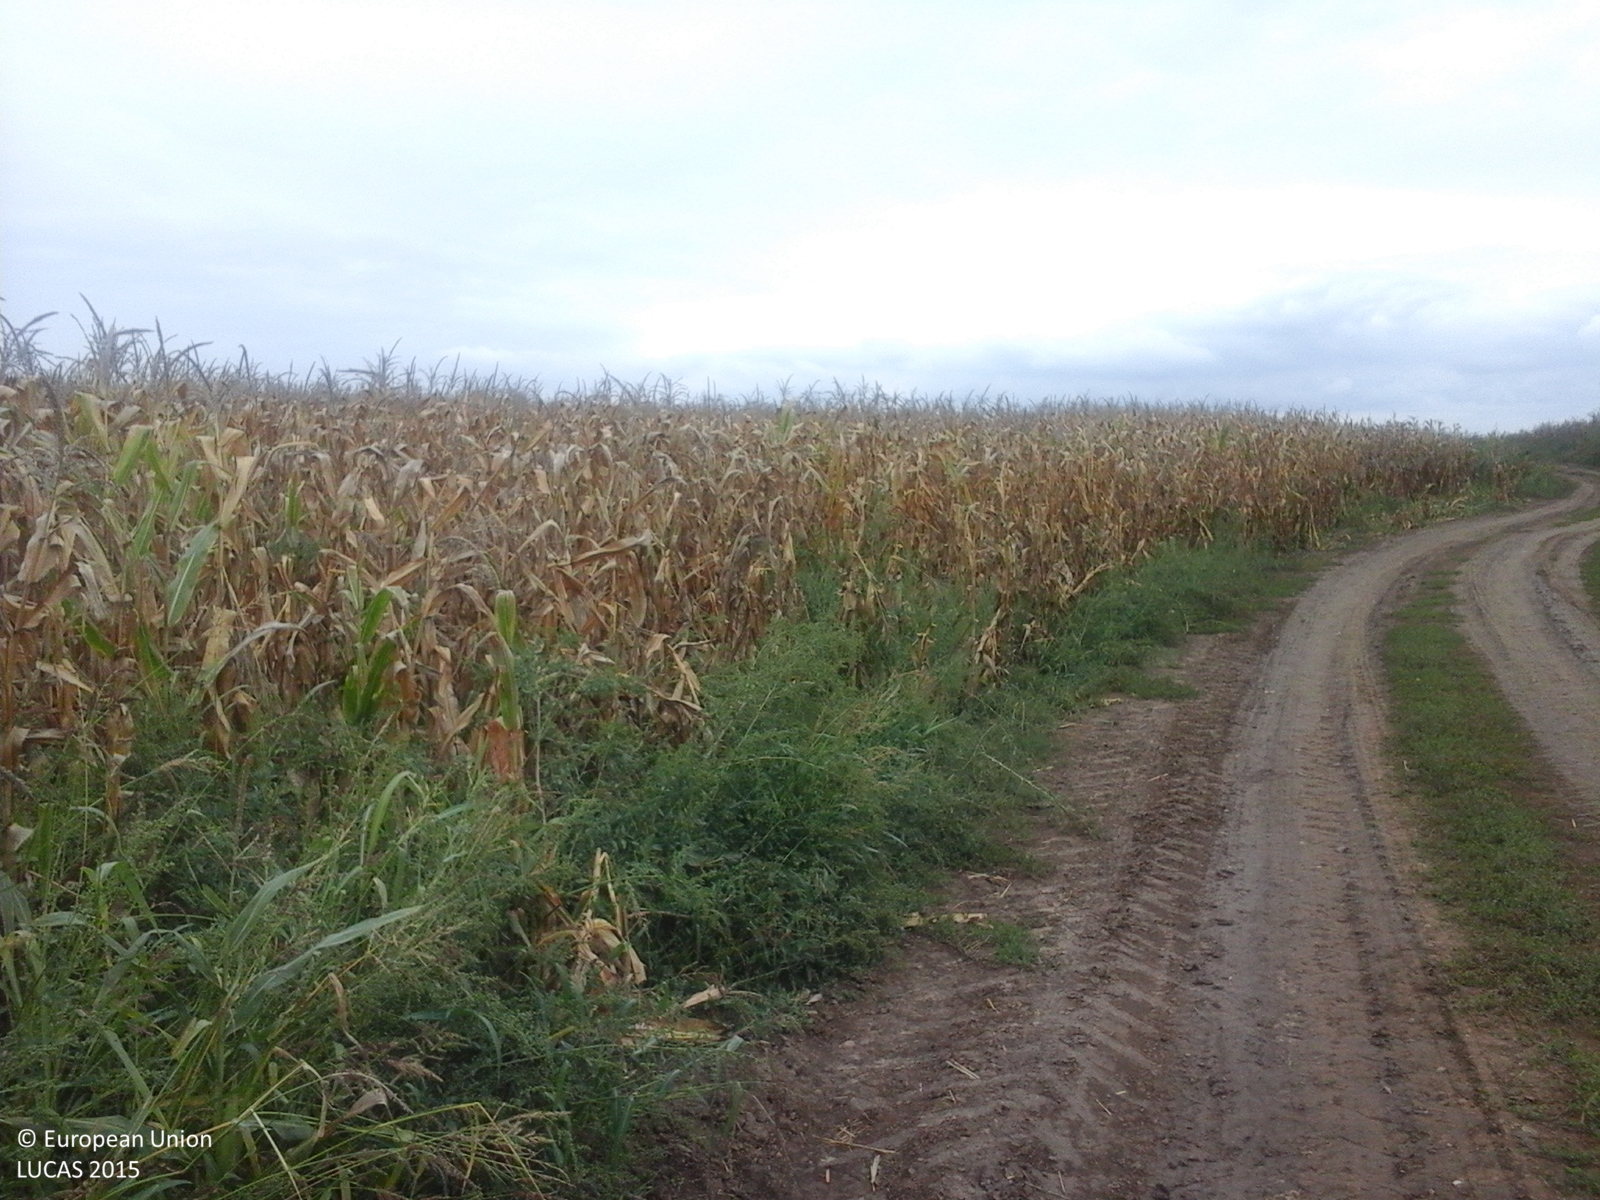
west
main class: Cropland
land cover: Maize
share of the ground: > 75 %
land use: Agriculture (excluding fallow land and kitchen gardens)
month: September
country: RO
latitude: 47.3349
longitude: 21.9453
